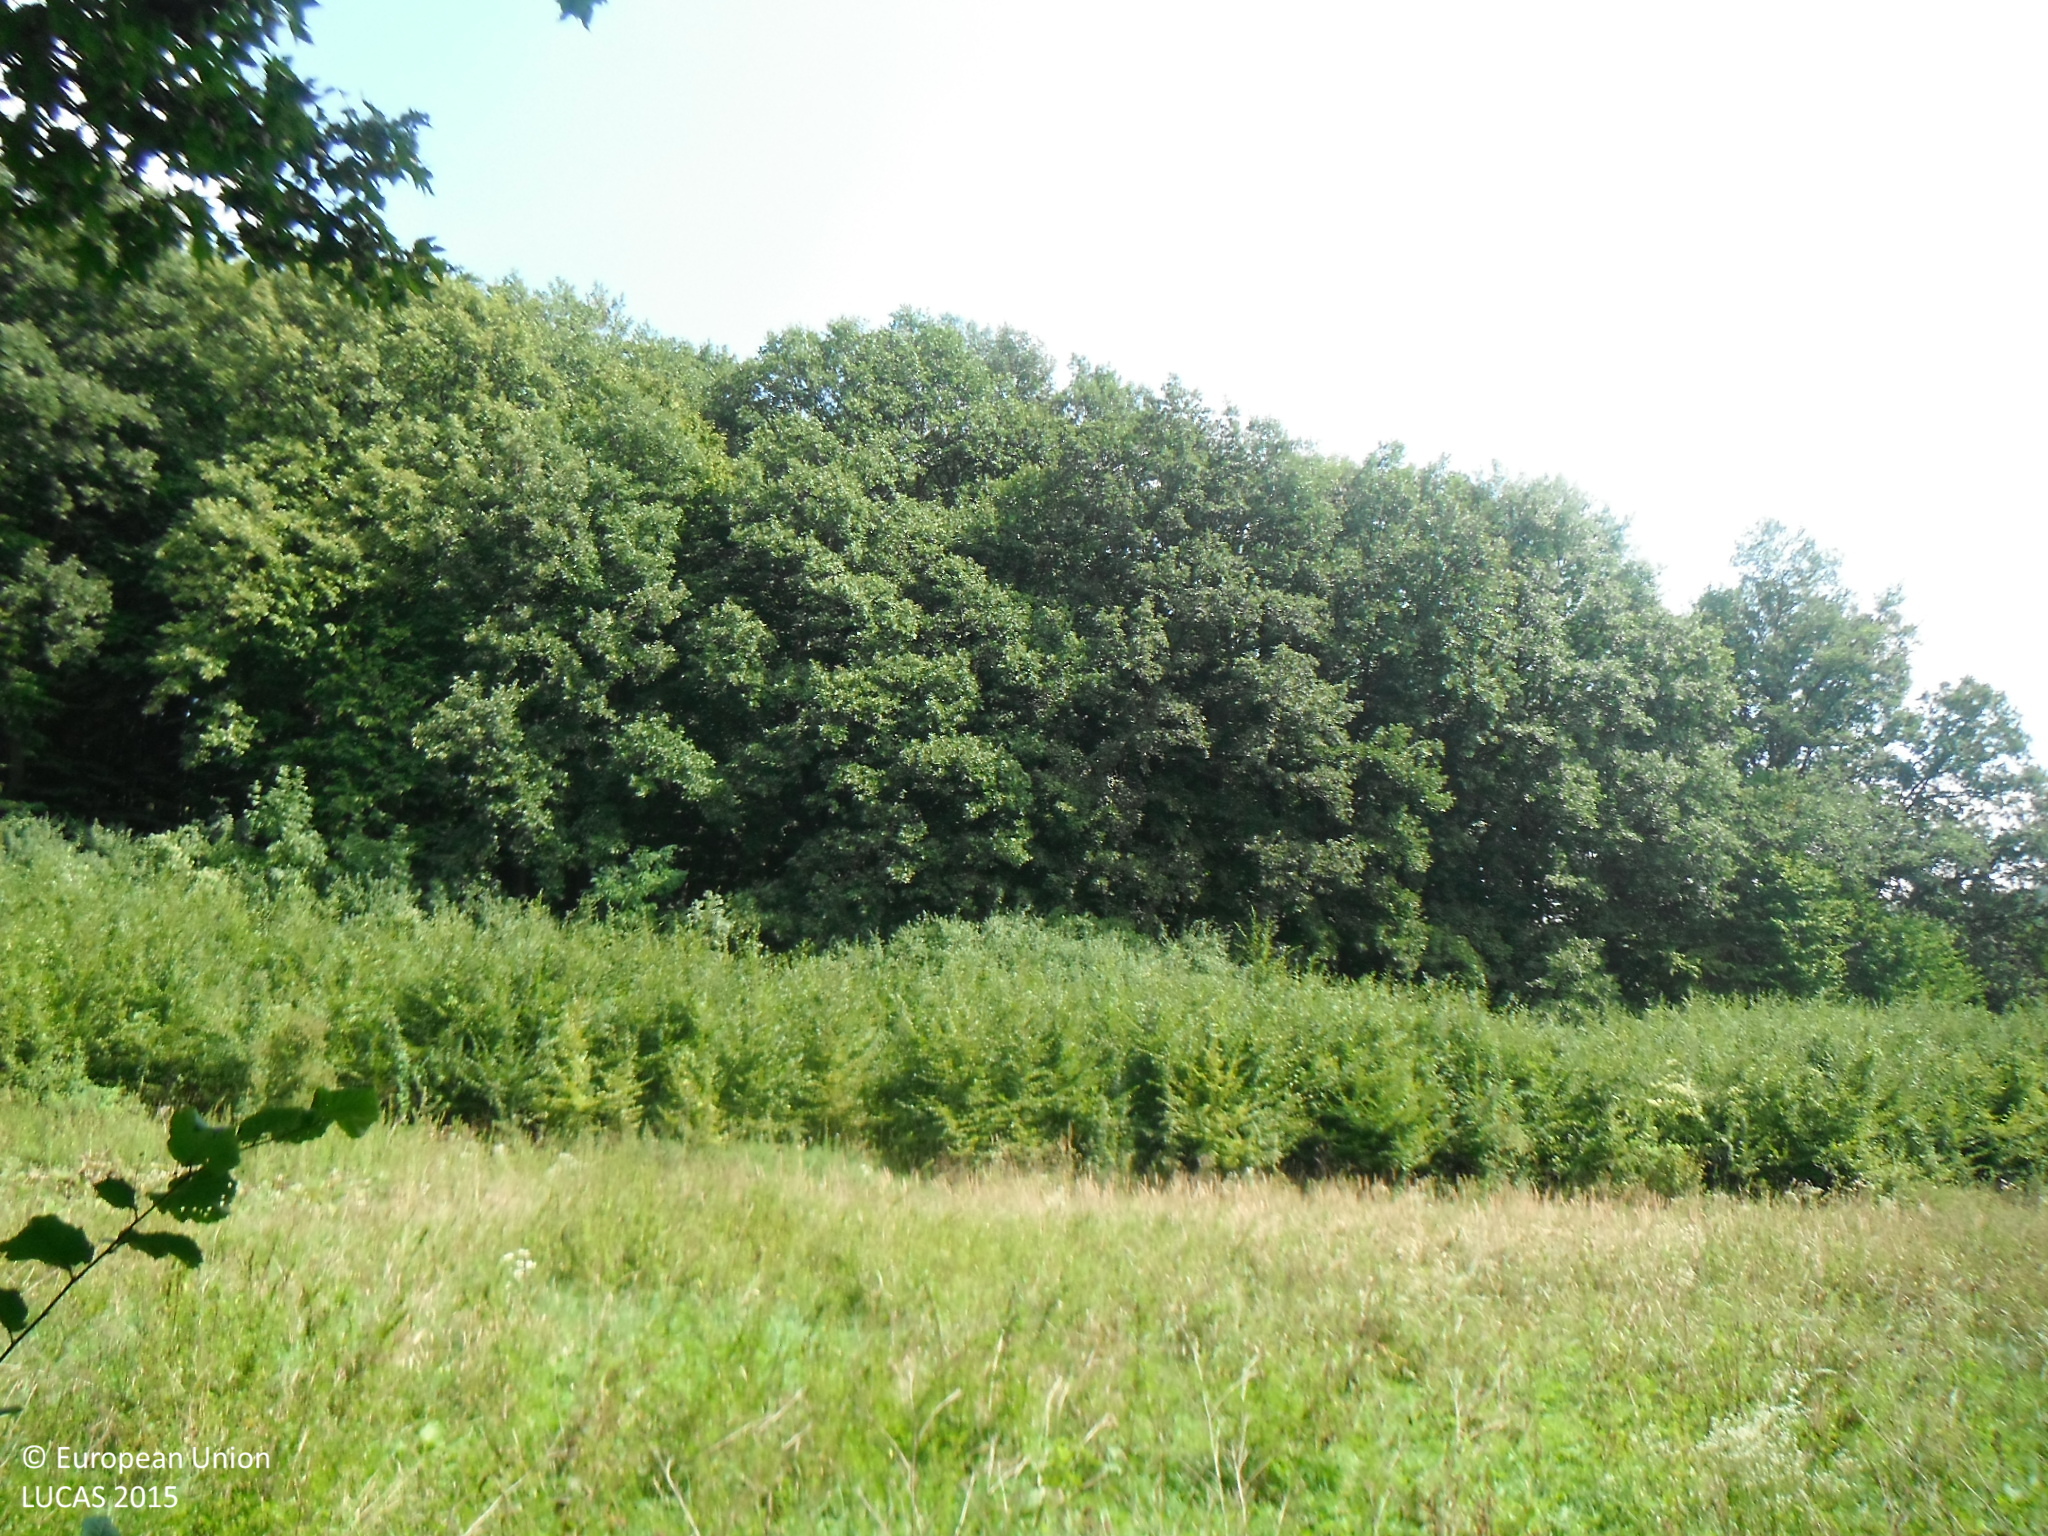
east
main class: Woodland
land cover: Broadleaved woodland
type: mesophytic deciduous forest
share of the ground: > 75 %
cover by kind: broadleaved forest trees 100 %
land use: Forestry
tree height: > 5 m
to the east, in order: Broadleaved woodland; Spontaneously vegetated surfaces; Broadleaved woodland; Tracks; Broadleaved woodland; Spontaneously vegetated surfaces; Broadleaved woodland
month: September
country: SK
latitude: 48.7464
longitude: 17.4772
